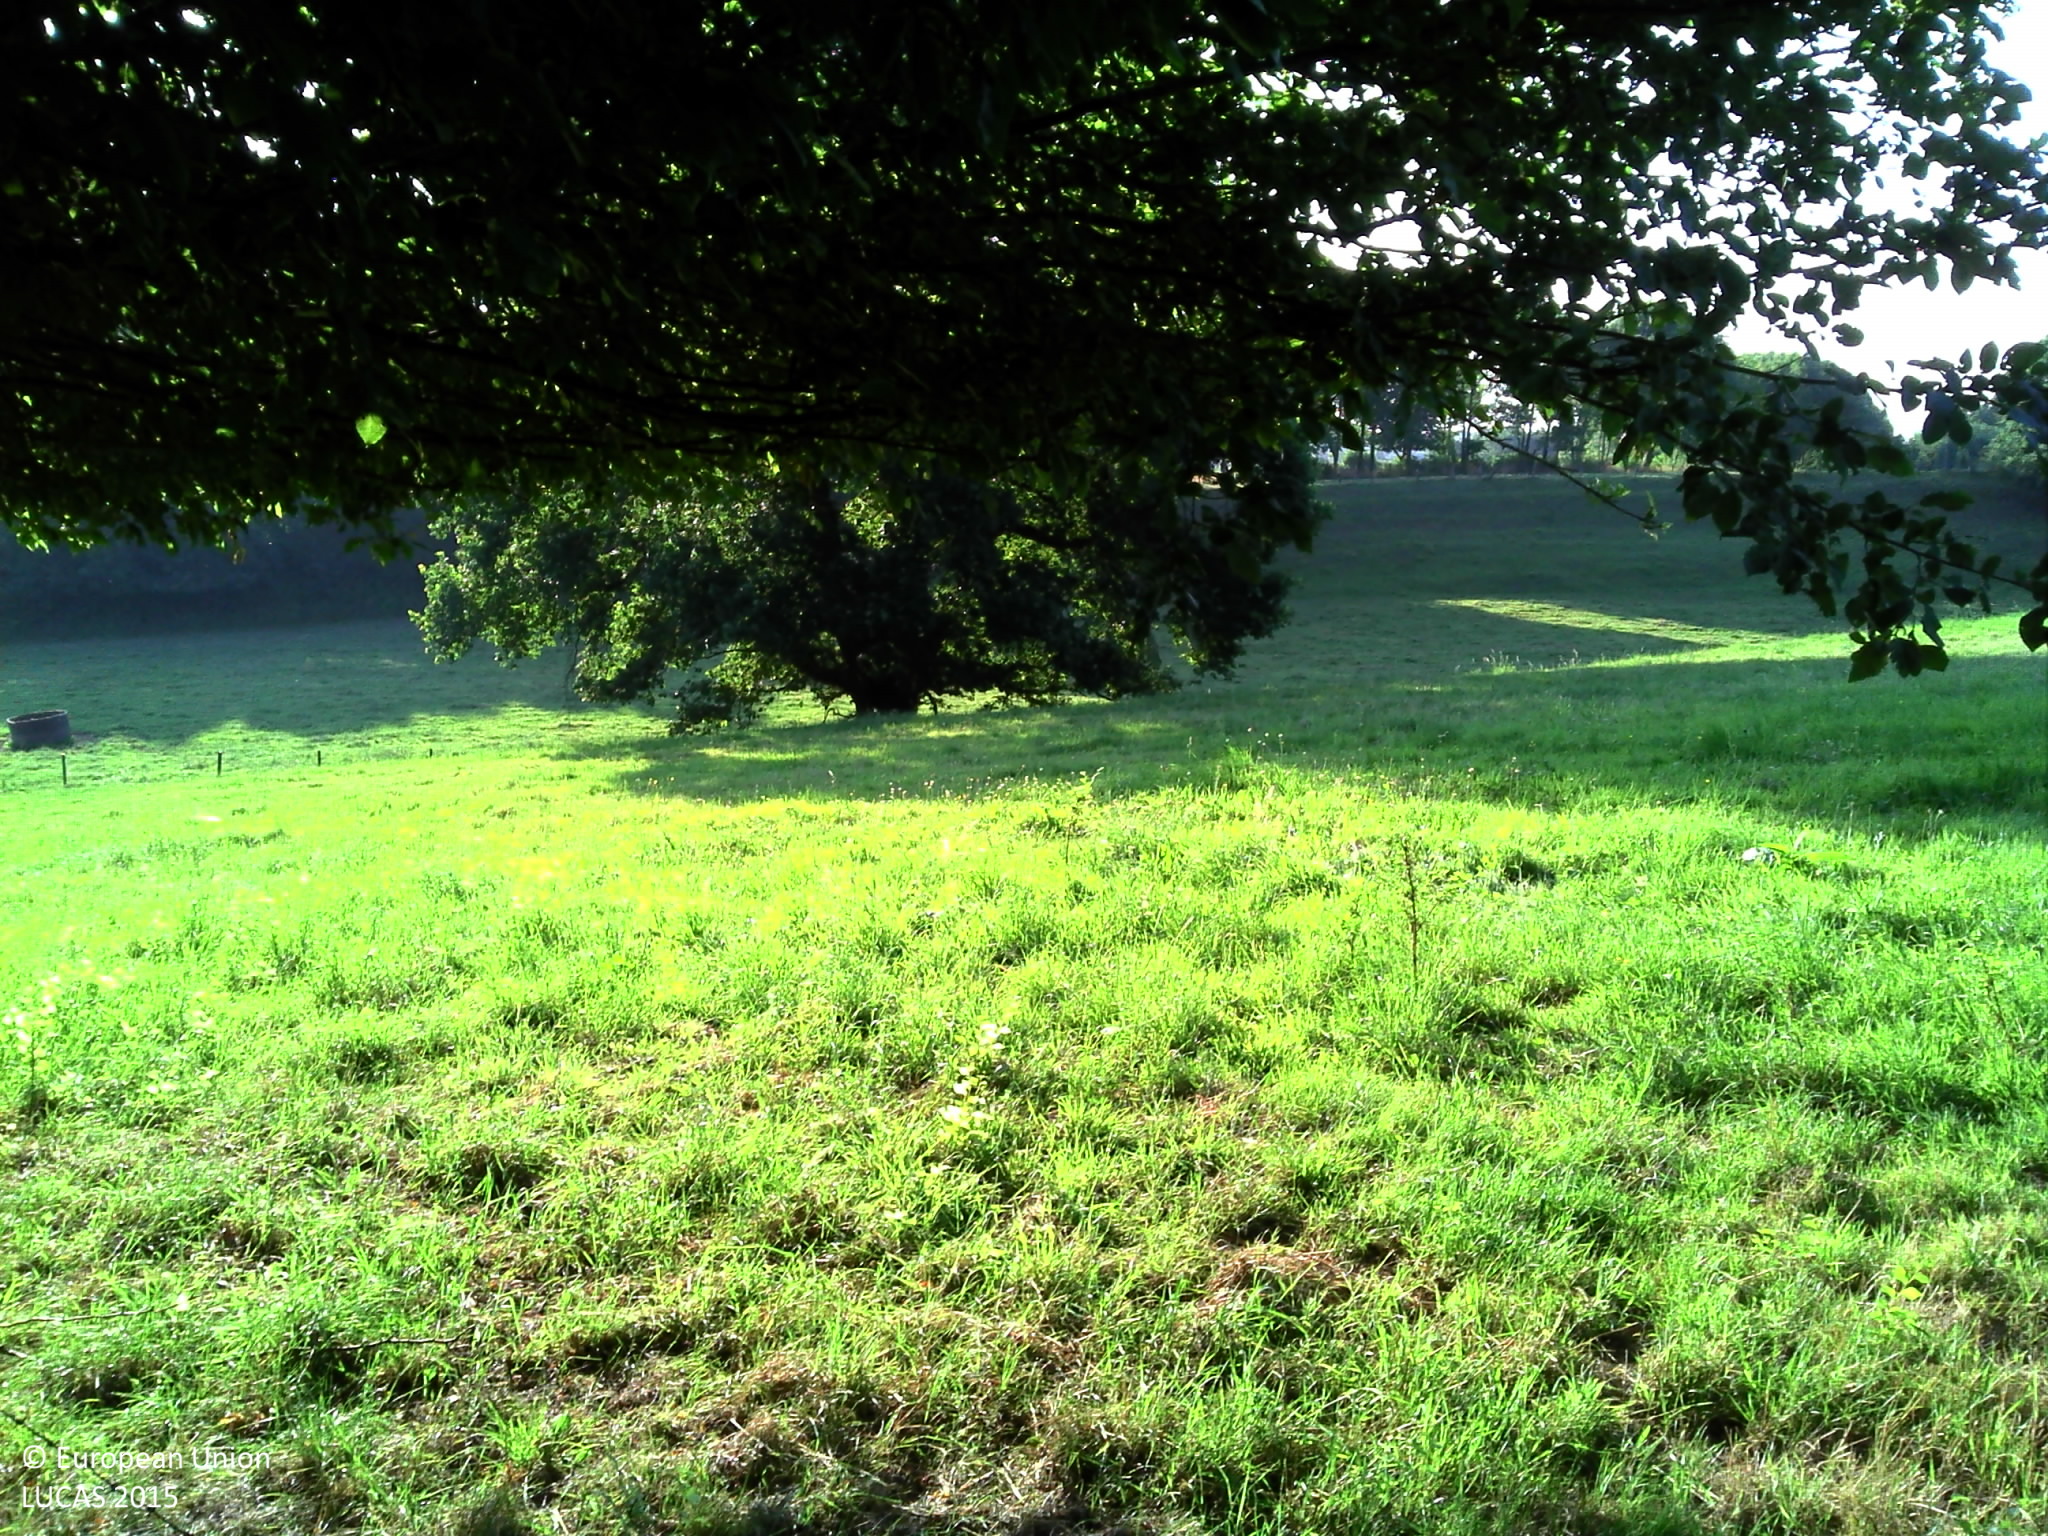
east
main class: Grassland
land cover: Grassland without tree/shrub cover
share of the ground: > 75 %
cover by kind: herbaceous plants 100 %
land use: Agriculture (excluding fallow land and kitchen gardens)
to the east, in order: Grassland without tree/shrub cover; Fences; Single bushes/trees; Rivers and streams; Fences; Grassland without tree/shrub cover; Broadleaved woodland; Grassland without tree/shrub cover; Fences; Tracks; Fences; Grassland without tree/shrub cover; Fences; Grassland without tree/shrub cover
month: July
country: BE
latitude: 50.4609
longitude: 4.0357
